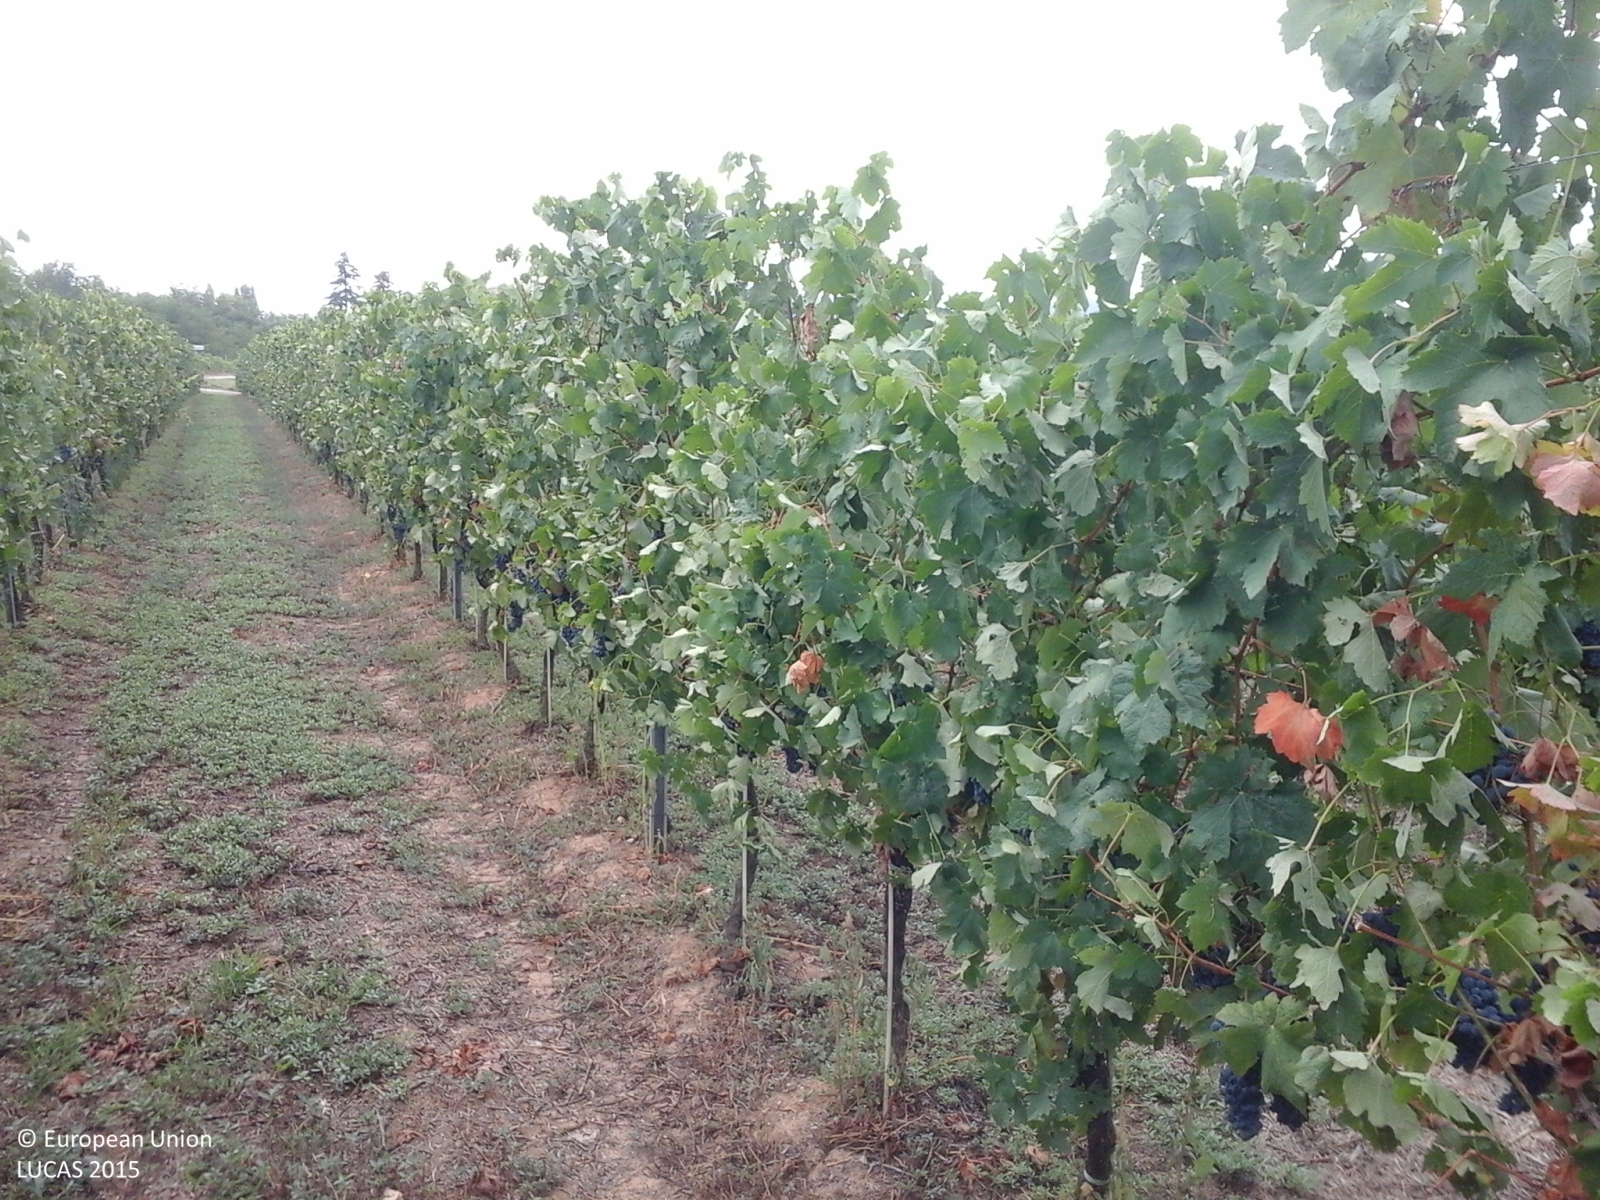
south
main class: Cropland
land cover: Vineyards
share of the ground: 50 - 75 %
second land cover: Grassland without tree/shrub cover
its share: > 75 %
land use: Agriculture (excluding fallow land and kitchen gardens)
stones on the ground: < 10 %
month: August
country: IT
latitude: 44.9778
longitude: 9.1014
